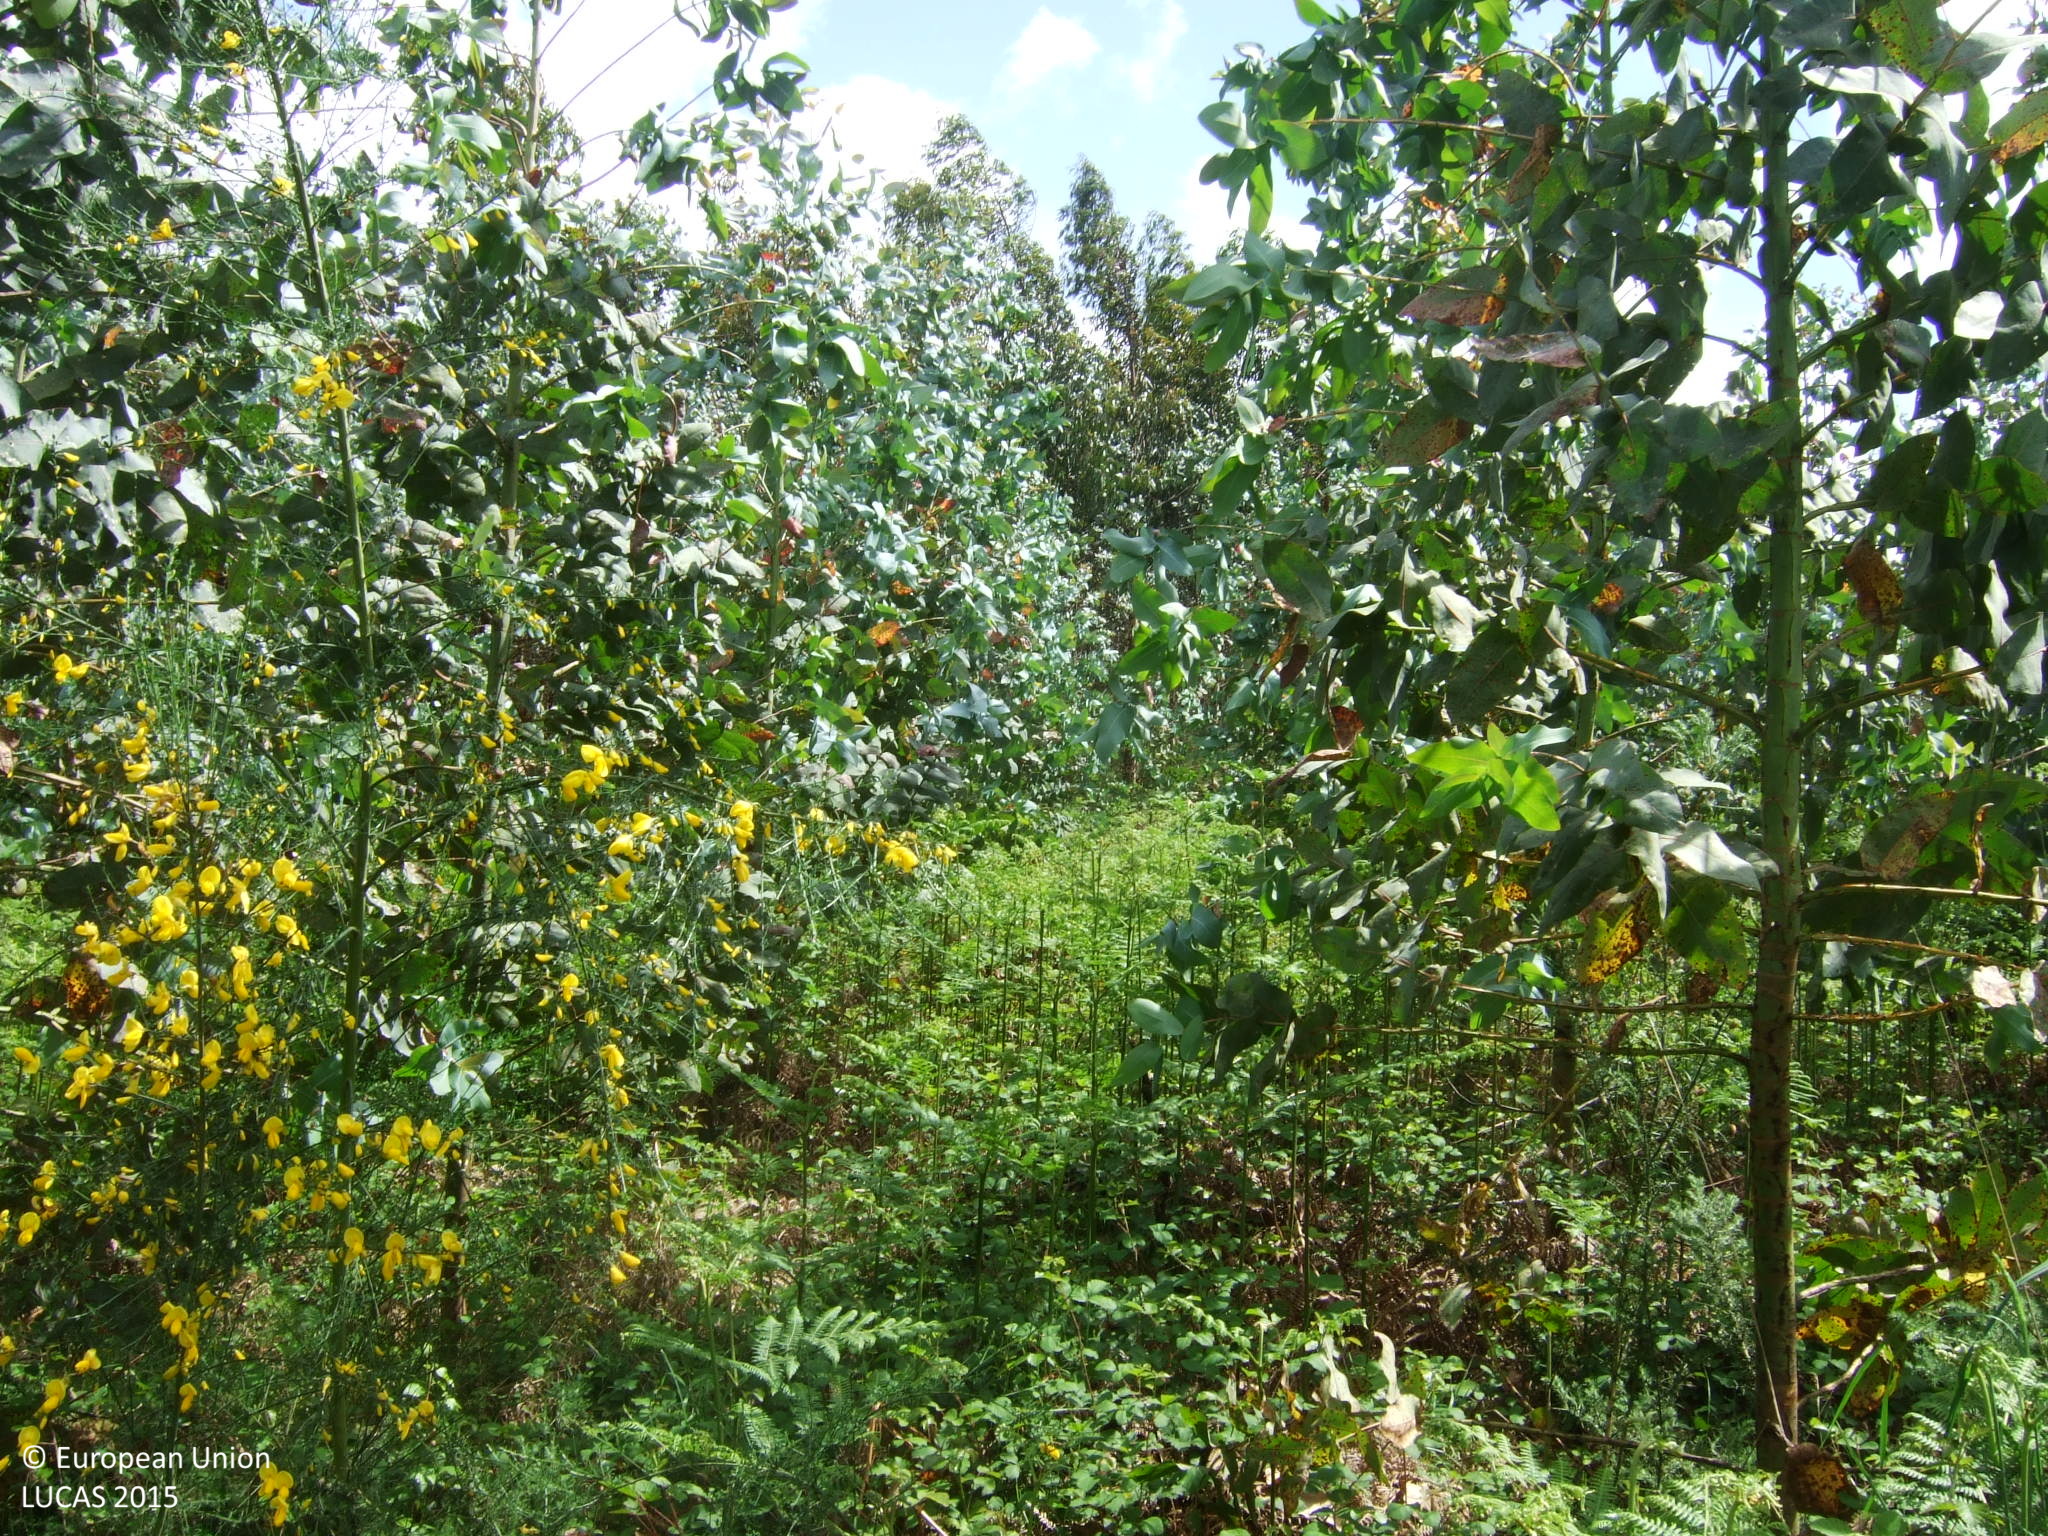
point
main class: Woodland
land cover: Broadleaved woodland
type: exotic forest
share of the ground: 25 - 50 %
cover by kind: shrubs 60 %, broadleaved forest trees 40 %
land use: Forestry
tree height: < 5 m
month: May
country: ES
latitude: 43.1215
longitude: -7.4173
